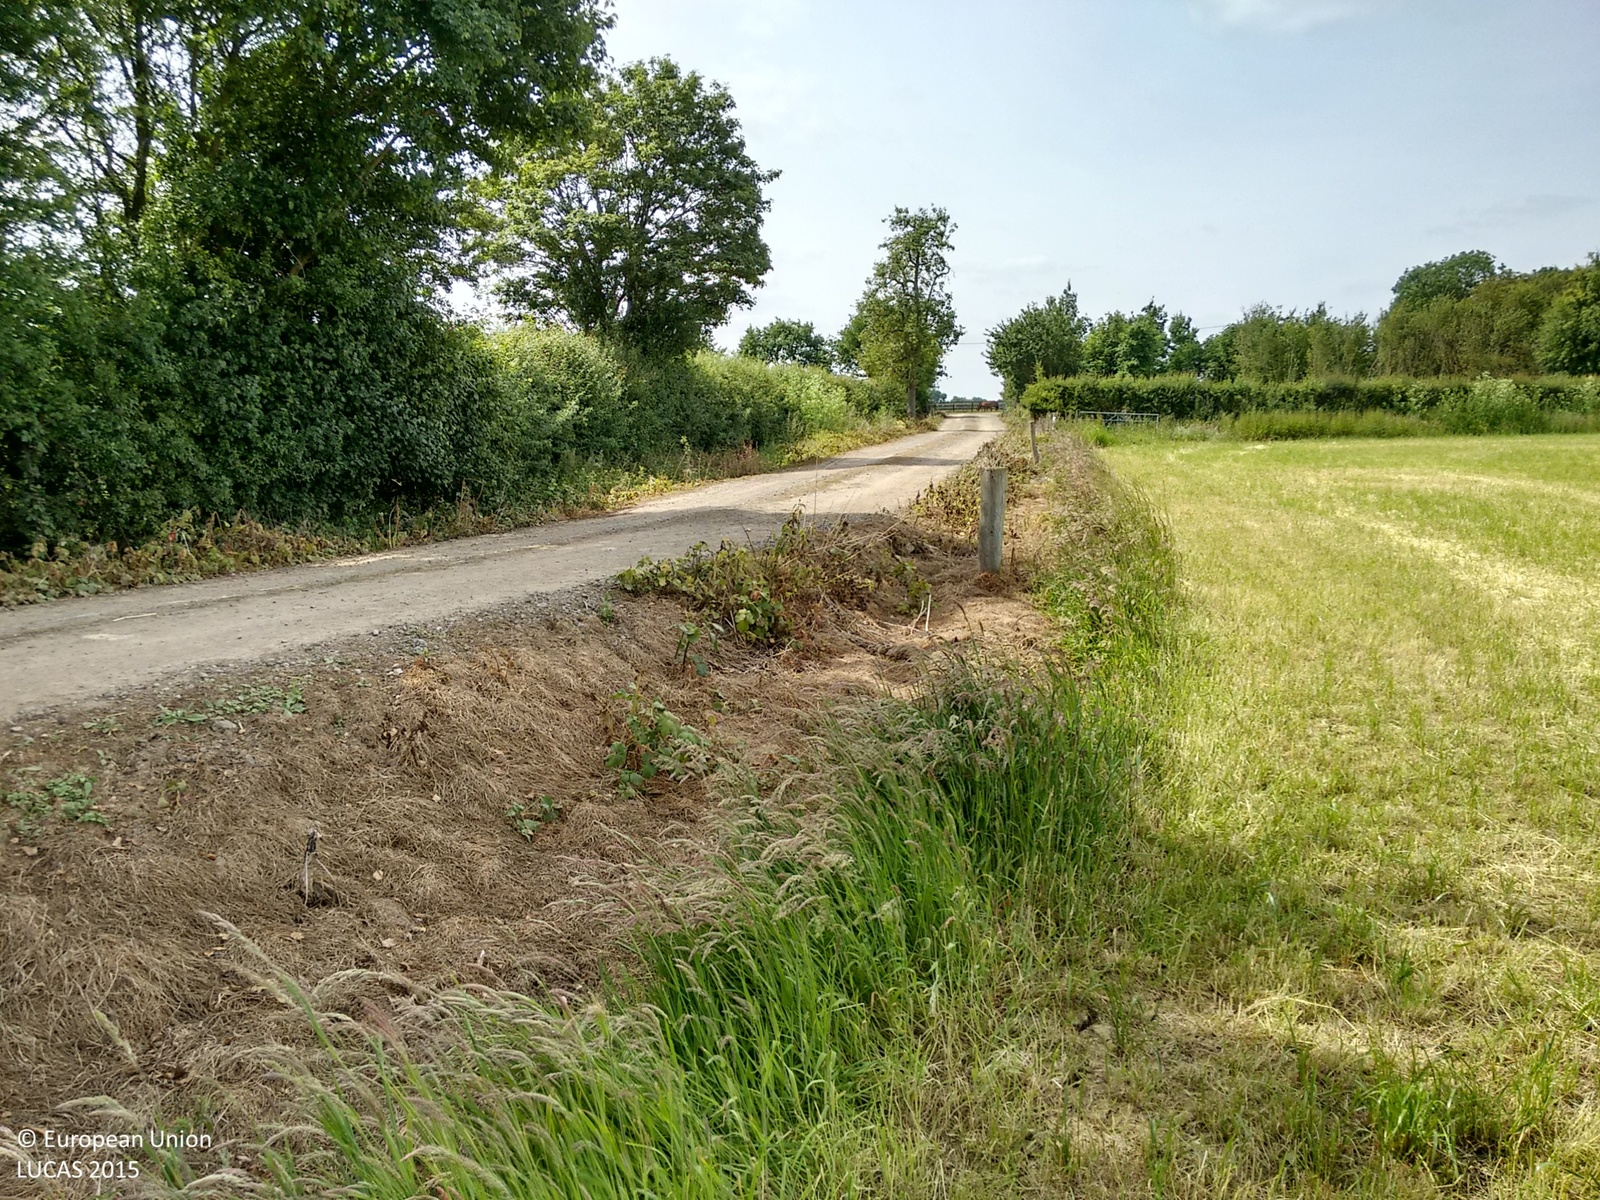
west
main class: Grassland
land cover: Grassland without tree/shrub cover
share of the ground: > 75 %
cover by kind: herbaceous plants 100 %
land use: Agriculture (excluding fallow land and kitchen gardens)
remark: Harvested field
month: June
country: GB
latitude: 51.8447
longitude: -1.2096
